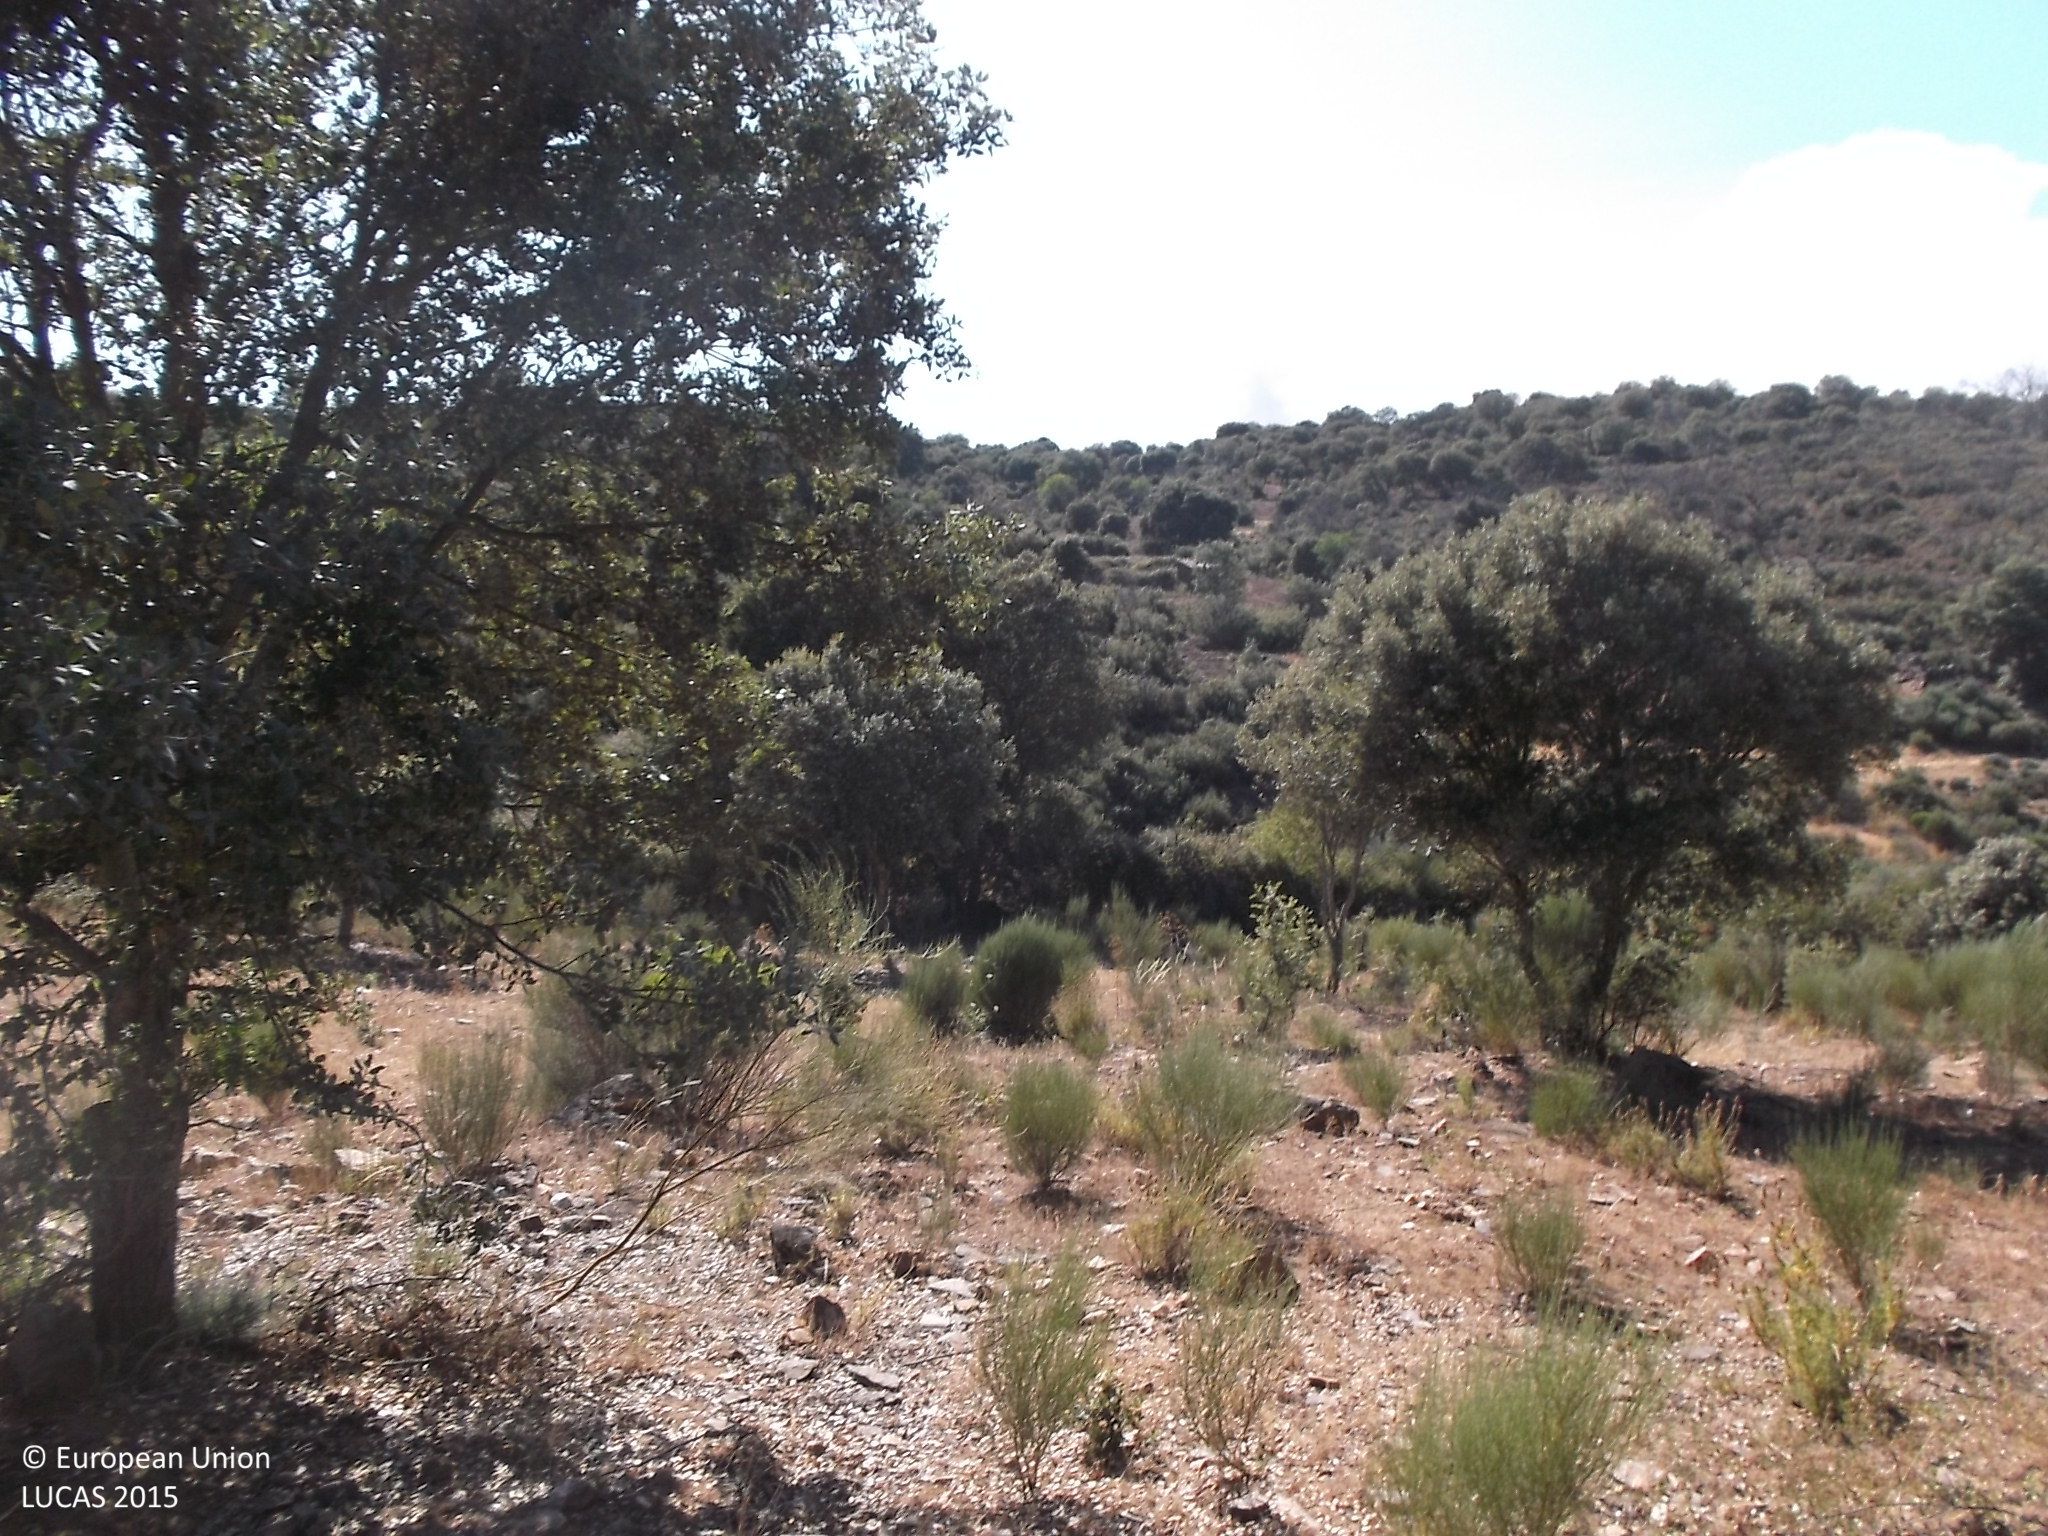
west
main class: Woodland
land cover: Broadleaved woodland
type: broadleaved evergreen forest
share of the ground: 25 - 50 %
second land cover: Shrubland without tree cover
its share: 25 - 50 %
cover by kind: herbaceous plants 40 %, broadleaved forest trees 30 %, shrubs 30 %
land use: Forestry
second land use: Agriculture (excluding fallow land and kitchen gardens)
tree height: < 5 m
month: July
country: ES
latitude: 40.8324
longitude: -6.8083
